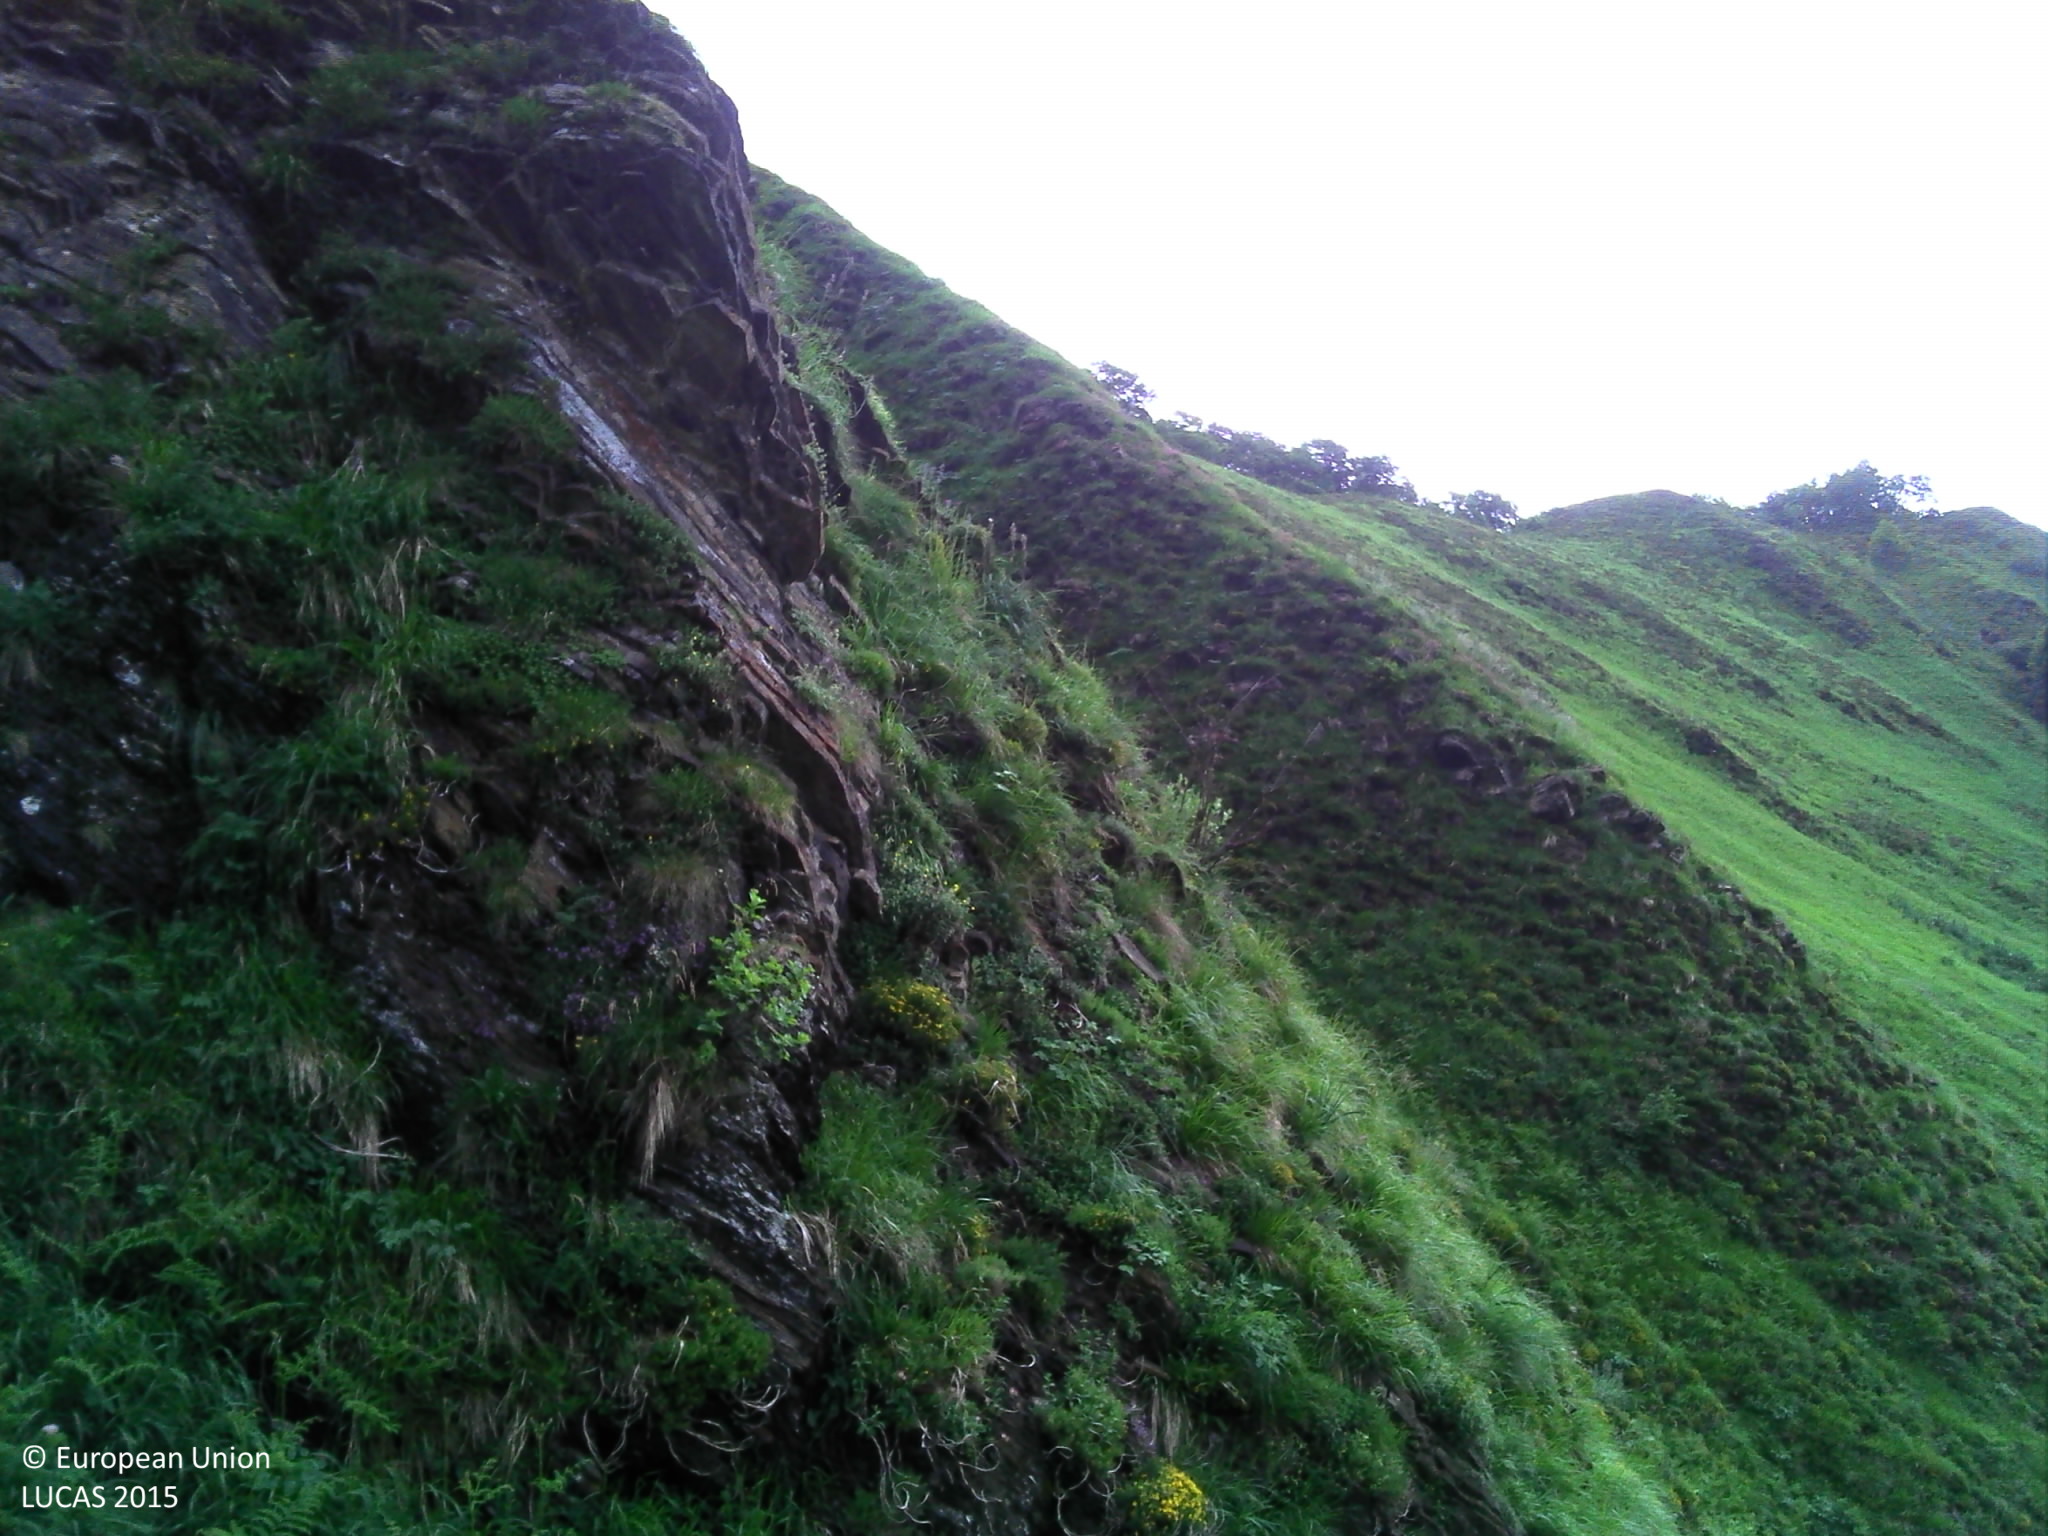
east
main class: Grassland
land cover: Grassland with sparse tree/shrub cover
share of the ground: > 75 %
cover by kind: herbaceous plants 85 %, shrubs 10 %, broadleaved forest trees 5 %
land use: Agriculture (excluding fallow land and kitchen gardens)
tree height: > 5 m
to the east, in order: Grassland with sparse tree/shrub cover; Rocks and stones; Grassland without tree/shrub cover; Rocks and stones; Grassland without tree/shrub cover; Broadleaved woodland
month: June
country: FR
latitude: 42.9455
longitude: -0.6569
